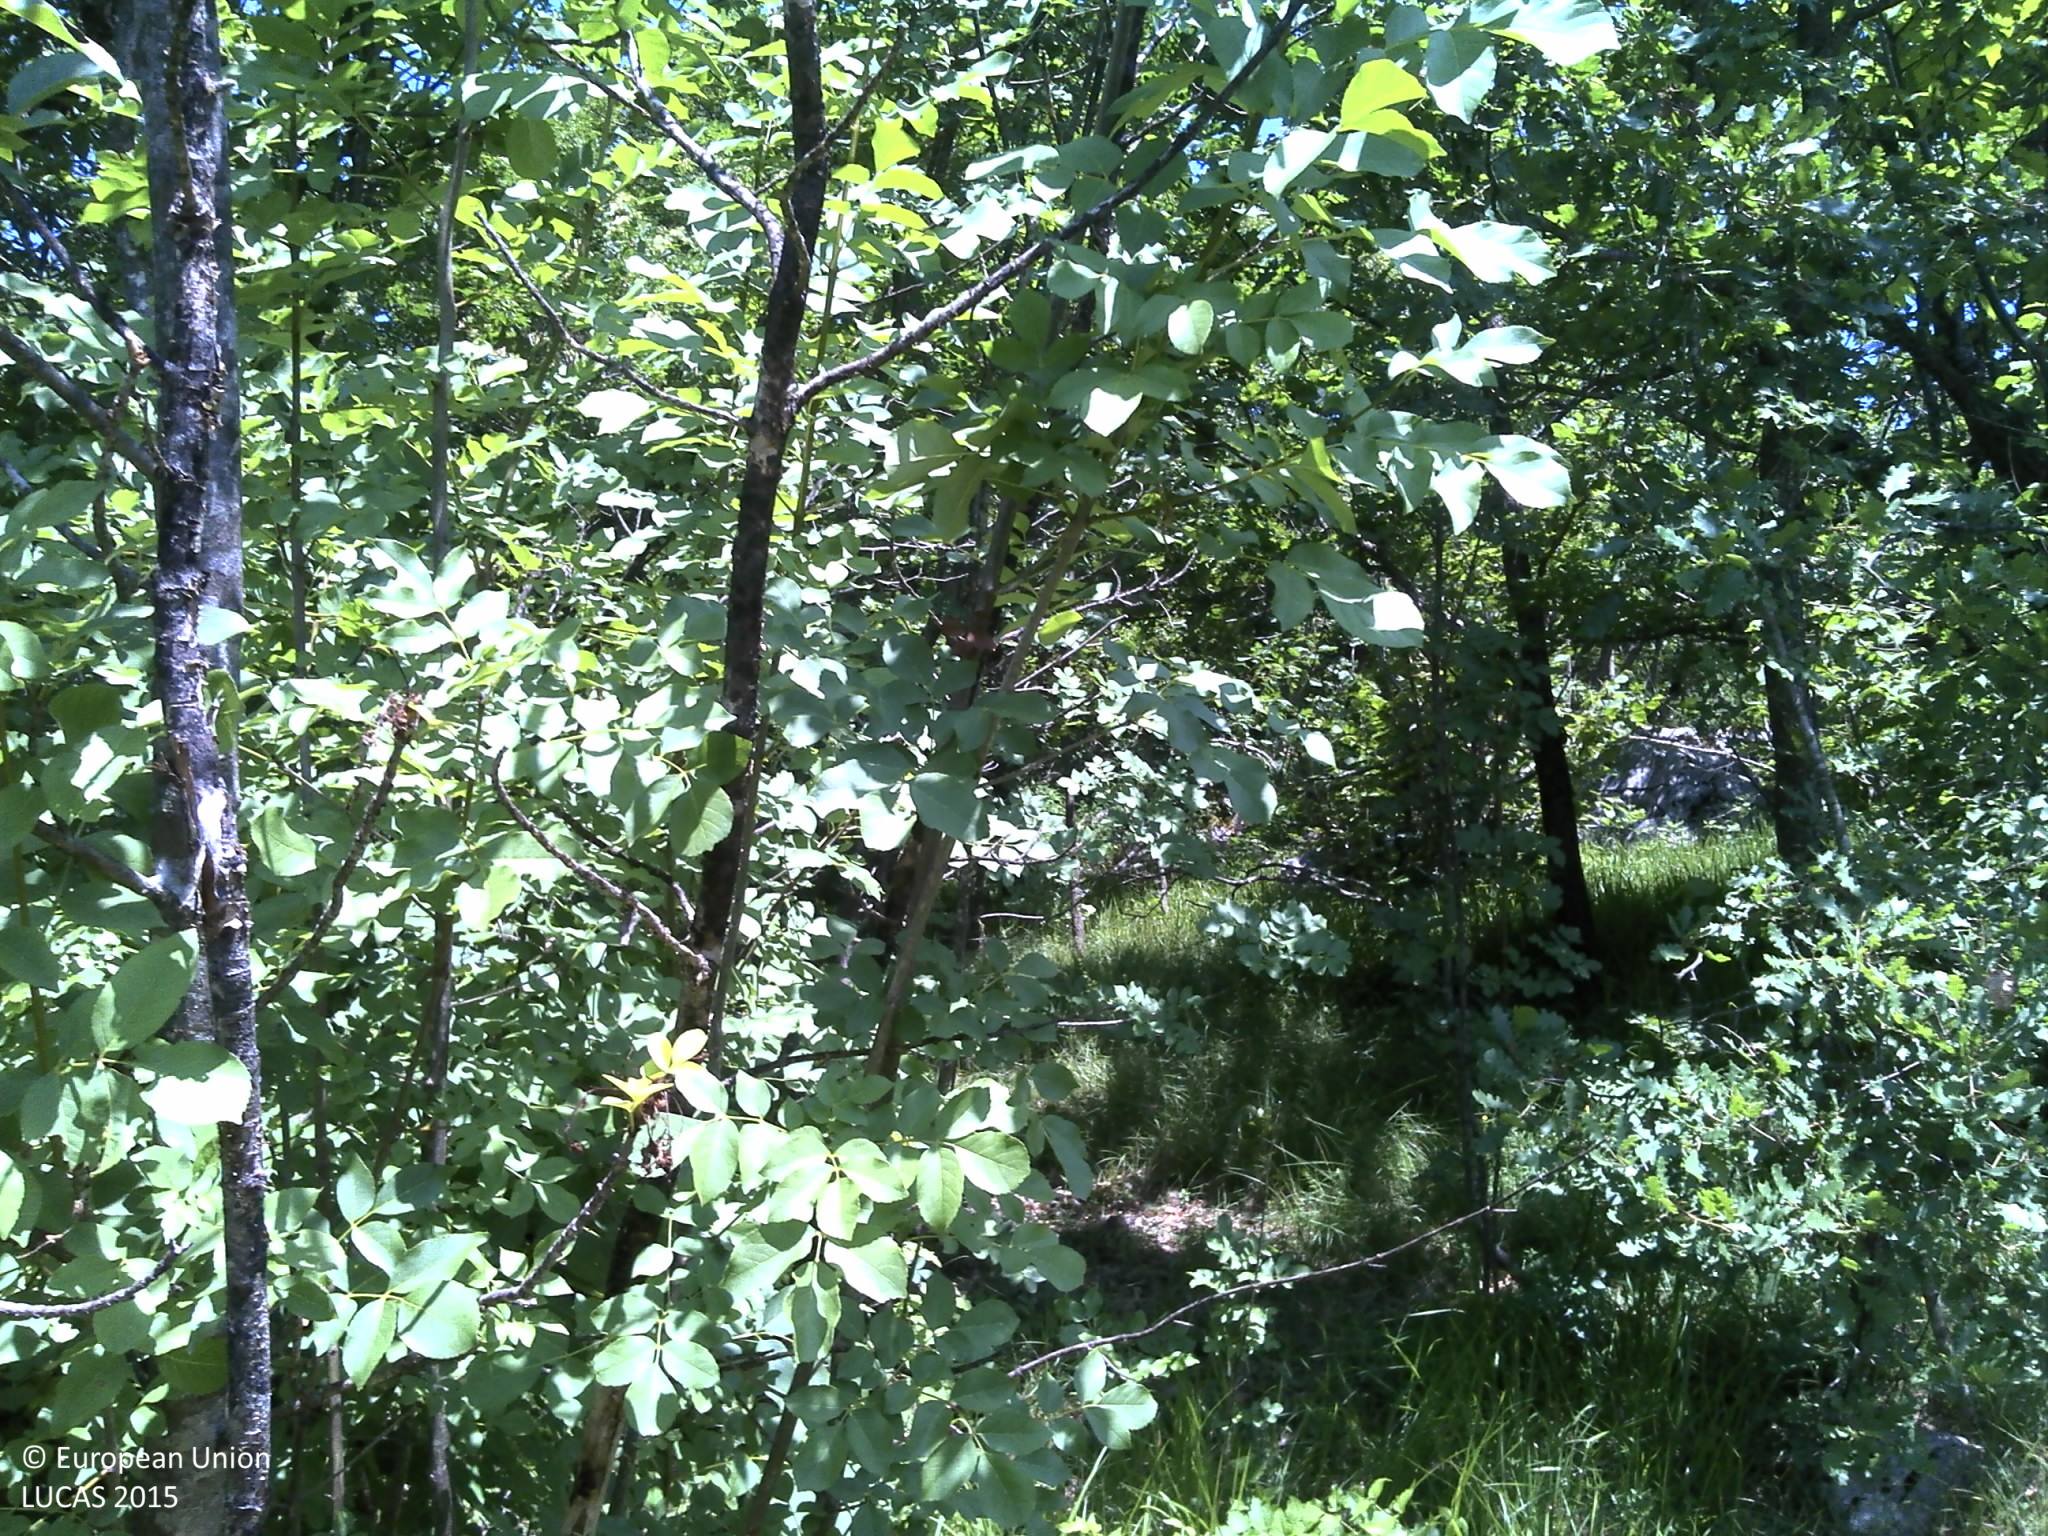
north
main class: Woodland
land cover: Broadleaved woodland
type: thermophilous deciduous forest
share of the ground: > 75 %
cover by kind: broadleaved forest trees 75 %, herbaceous plants 20 %, consolidated bare surface 5 %
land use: Semi-natural and natural areas not in use
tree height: > 5 m
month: June
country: HR
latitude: 44.4379
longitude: 15.5337
